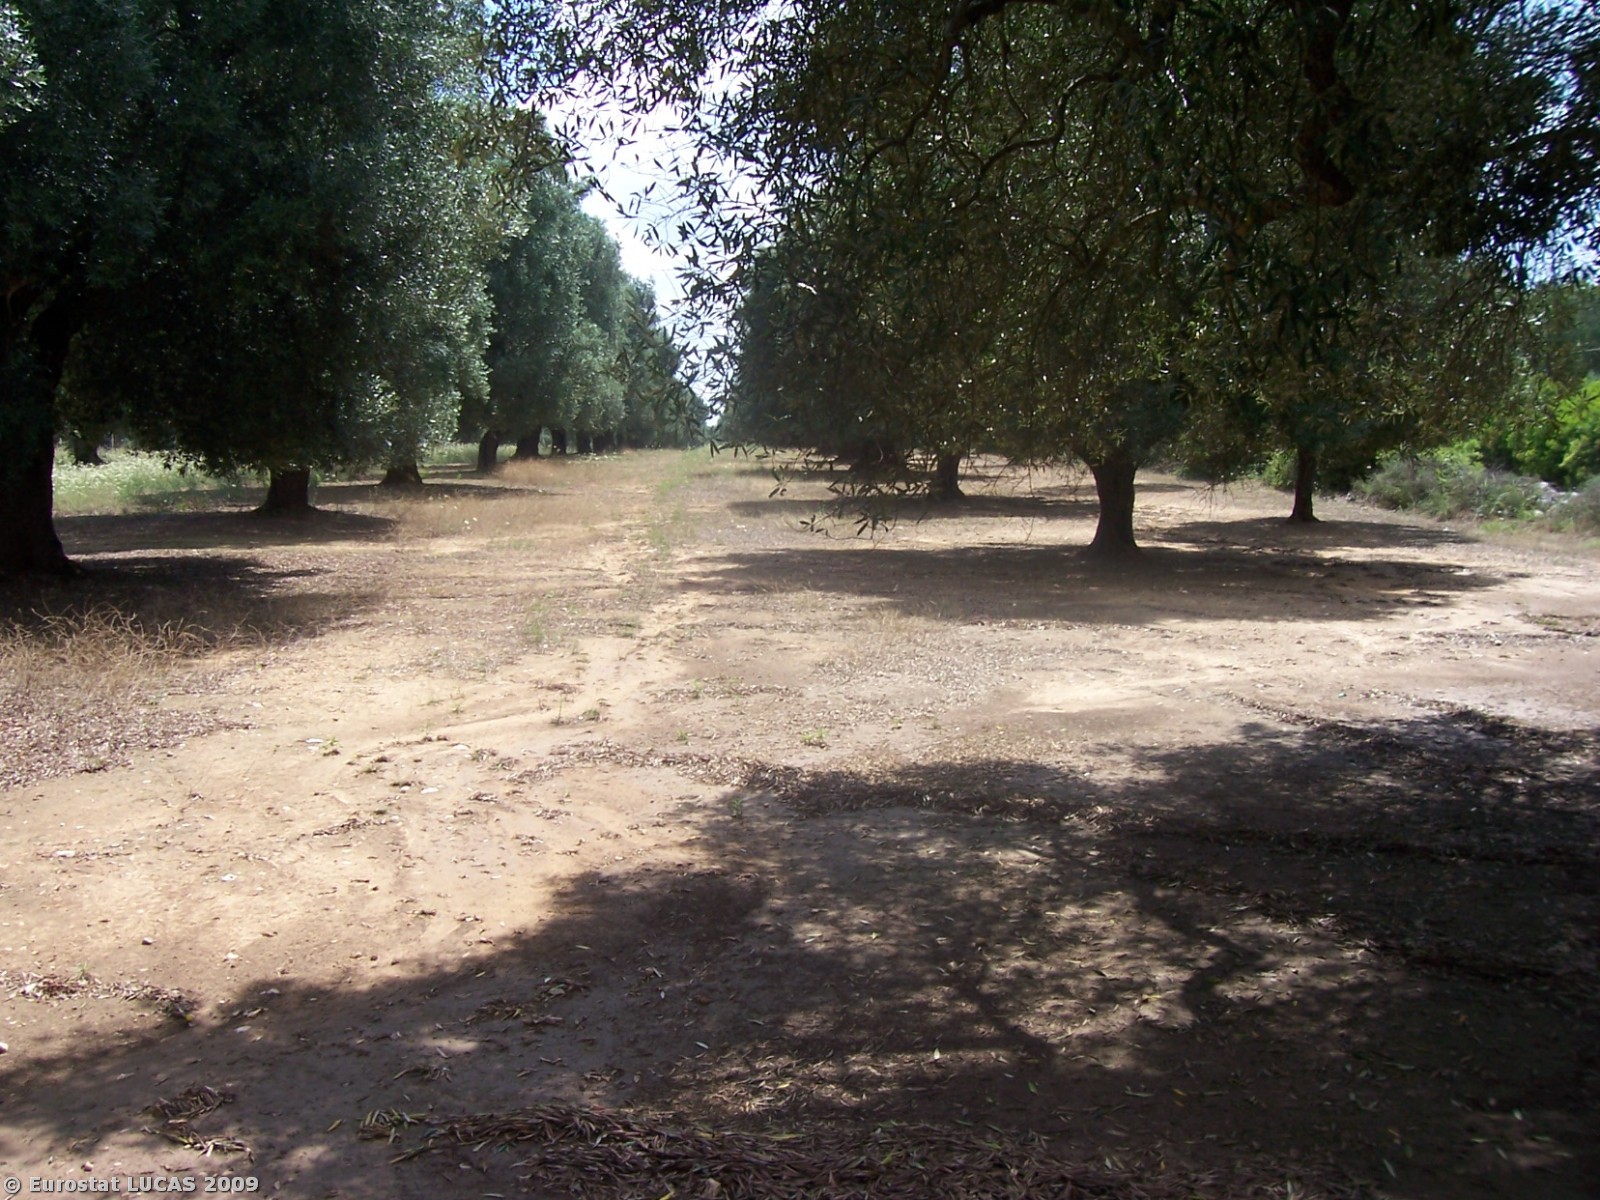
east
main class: Cropland
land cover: Olive groves
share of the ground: 50 - 75 %
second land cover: Bare land
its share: > 75 %
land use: Agriculture (excluding fallow land and kitchen gardens)
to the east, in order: Olive groves; Bare land
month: July
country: IT
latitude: 40.5234
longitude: 17.5186
